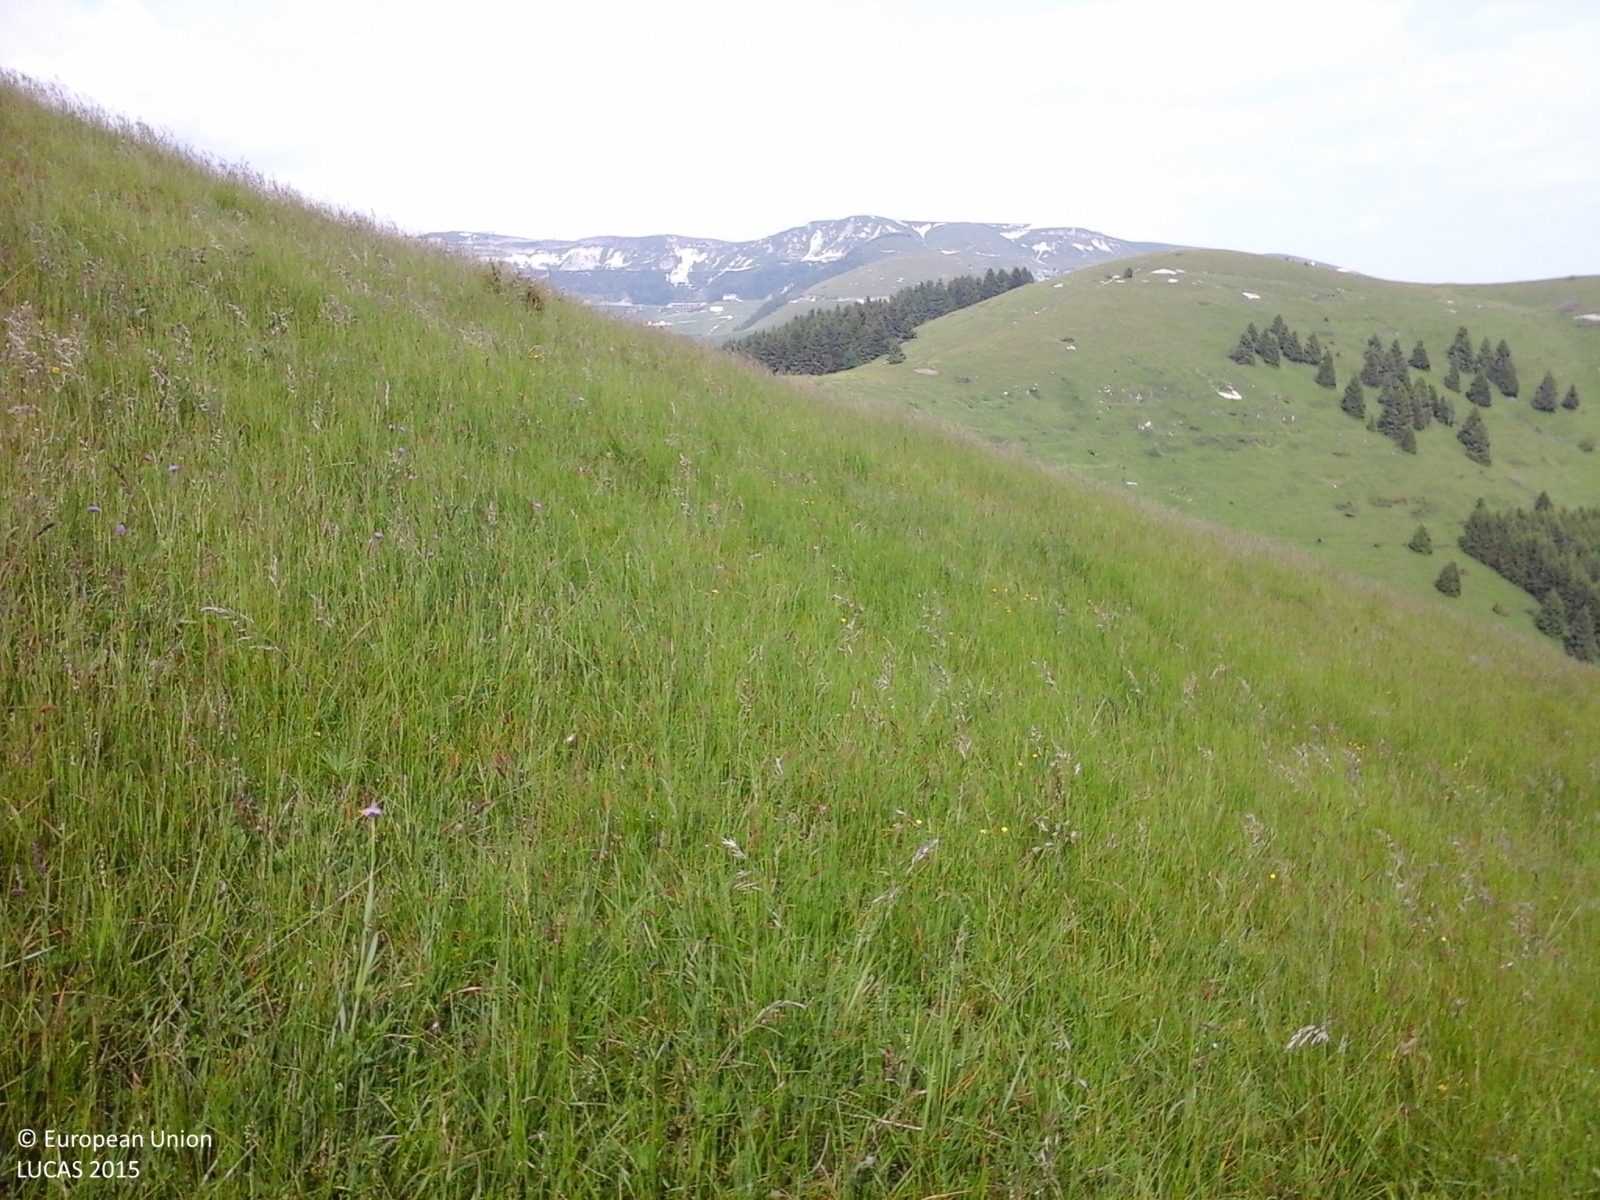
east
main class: Grassland
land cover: Grassland without tree/shrub cover
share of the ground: > 75 %
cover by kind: herbaceous plants 100 %
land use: Agriculture (excluding fallow land and kitchen gardens)
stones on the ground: 10 - 25 %
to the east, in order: Grassland without tree/shrub cover; Tracks; Grassland without tree/shrub cover; Spruce dominated coniferous woodland
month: June
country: IT
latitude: 45.8682
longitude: 11.7623
